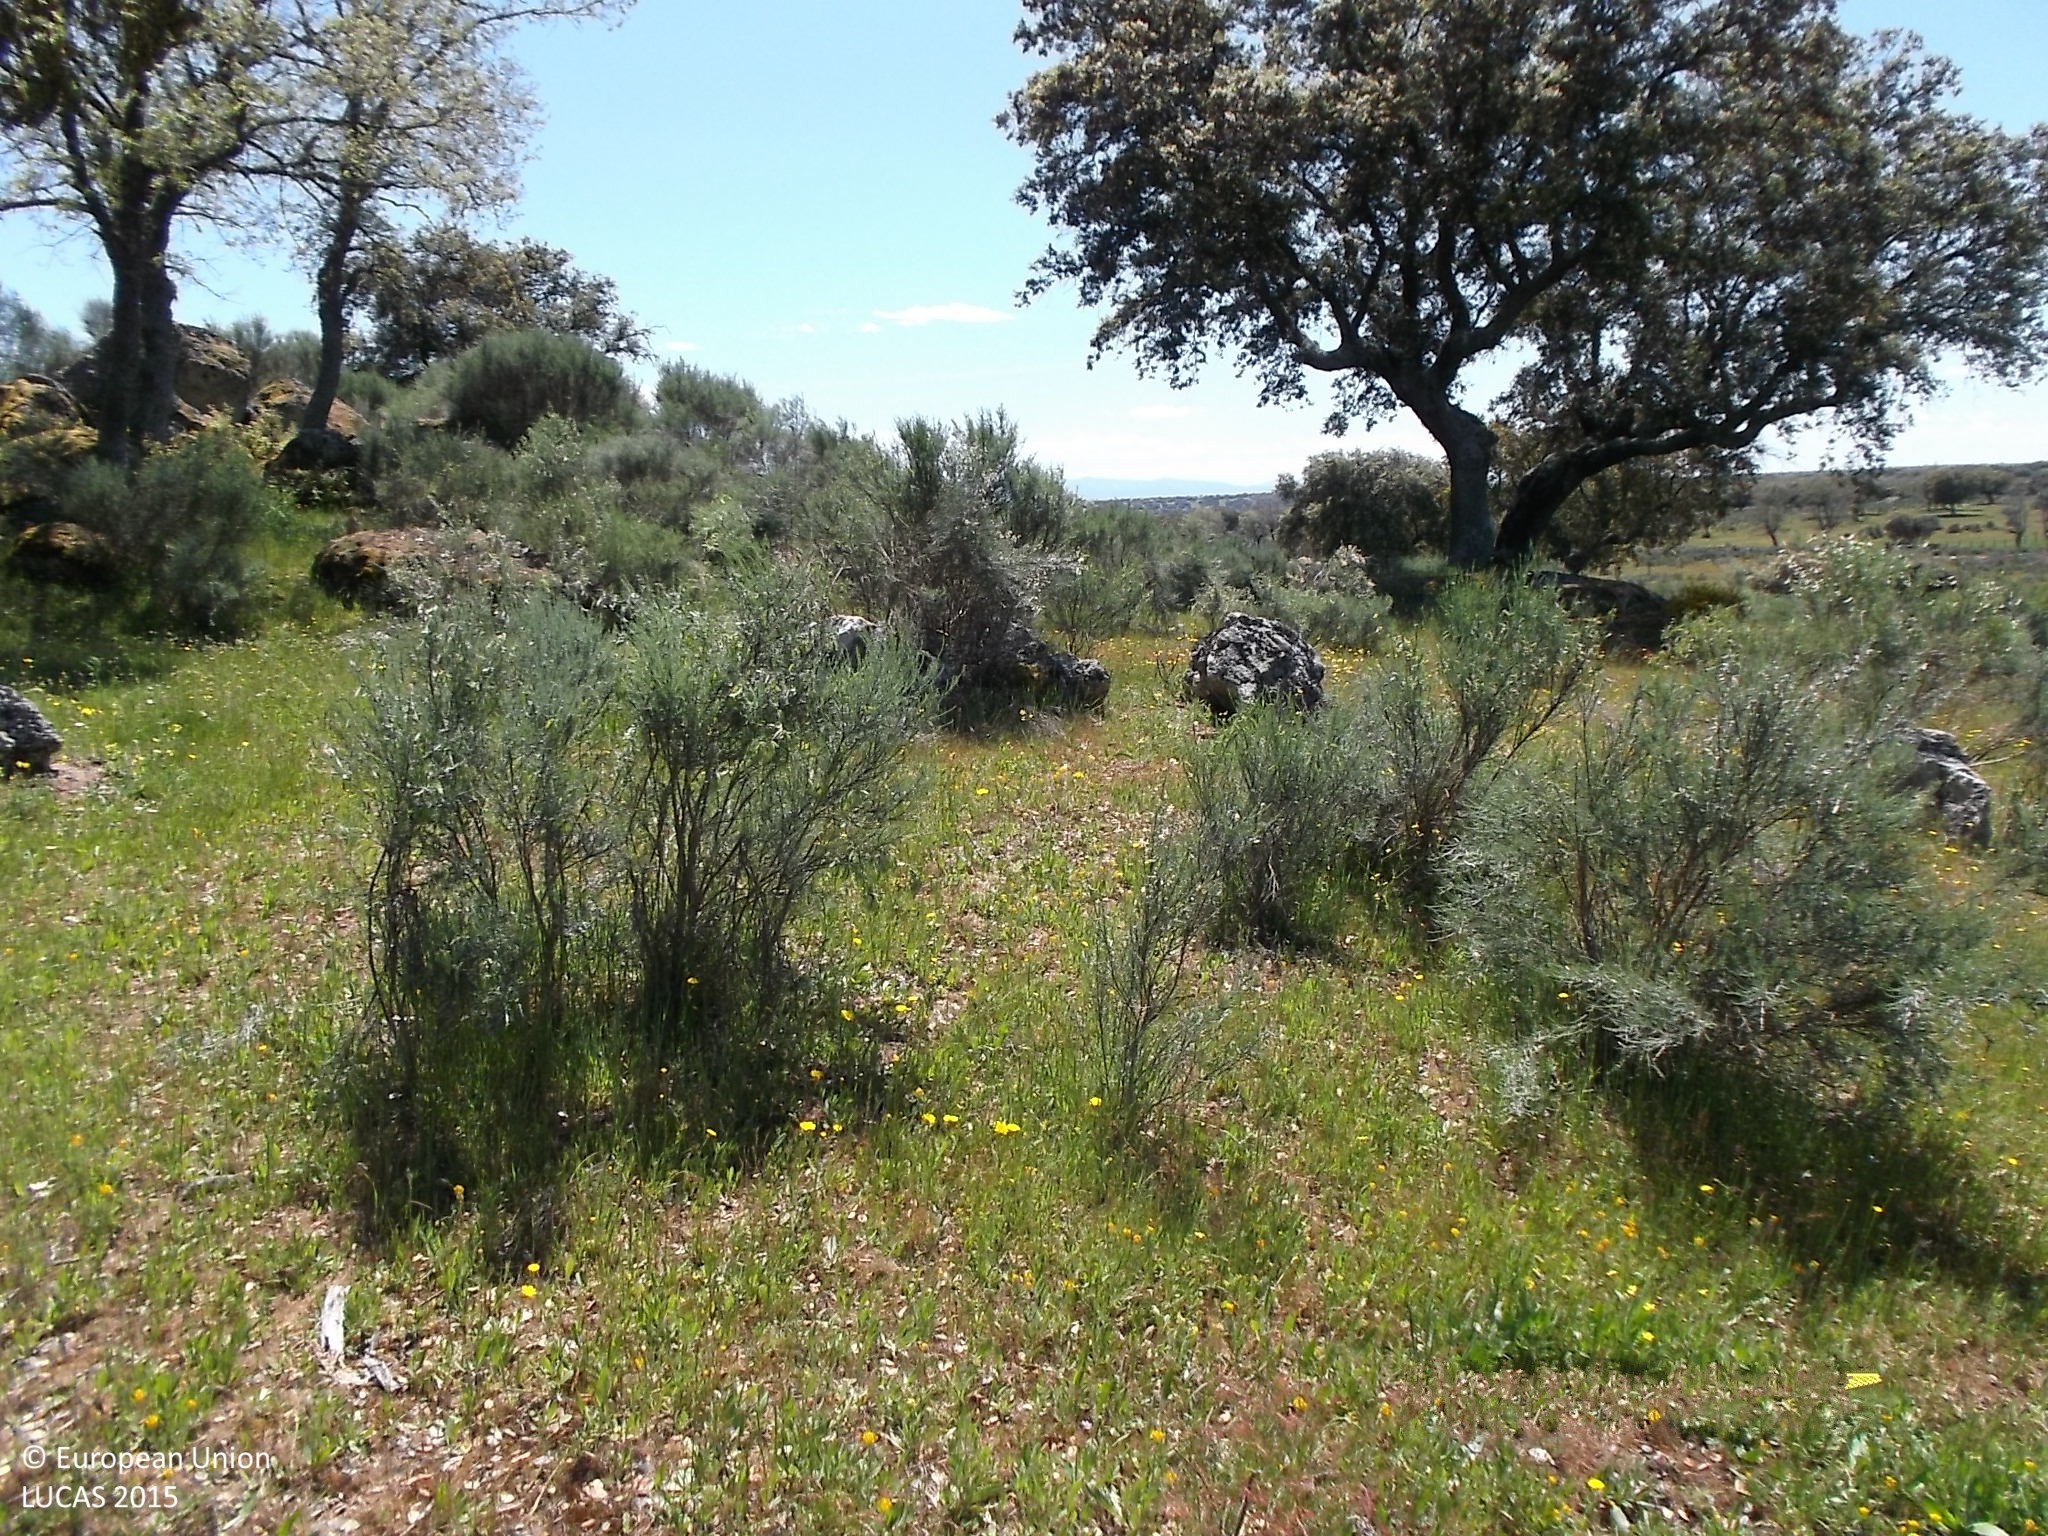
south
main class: Woodland
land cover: Broadleaved woodland
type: broadleaved evergreen forest
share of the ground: 10 - 25 %
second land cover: Grassland without tree/shrub cover
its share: > 75 %
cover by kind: herbaceous plants 70 %, broadleaved forest trees 20 %, shrubs 10 %
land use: Forestry
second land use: Agriculture (excluding fallow land and kitchen gardens)
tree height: > 5 m
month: May
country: ES
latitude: 40.9091
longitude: -6.2464
